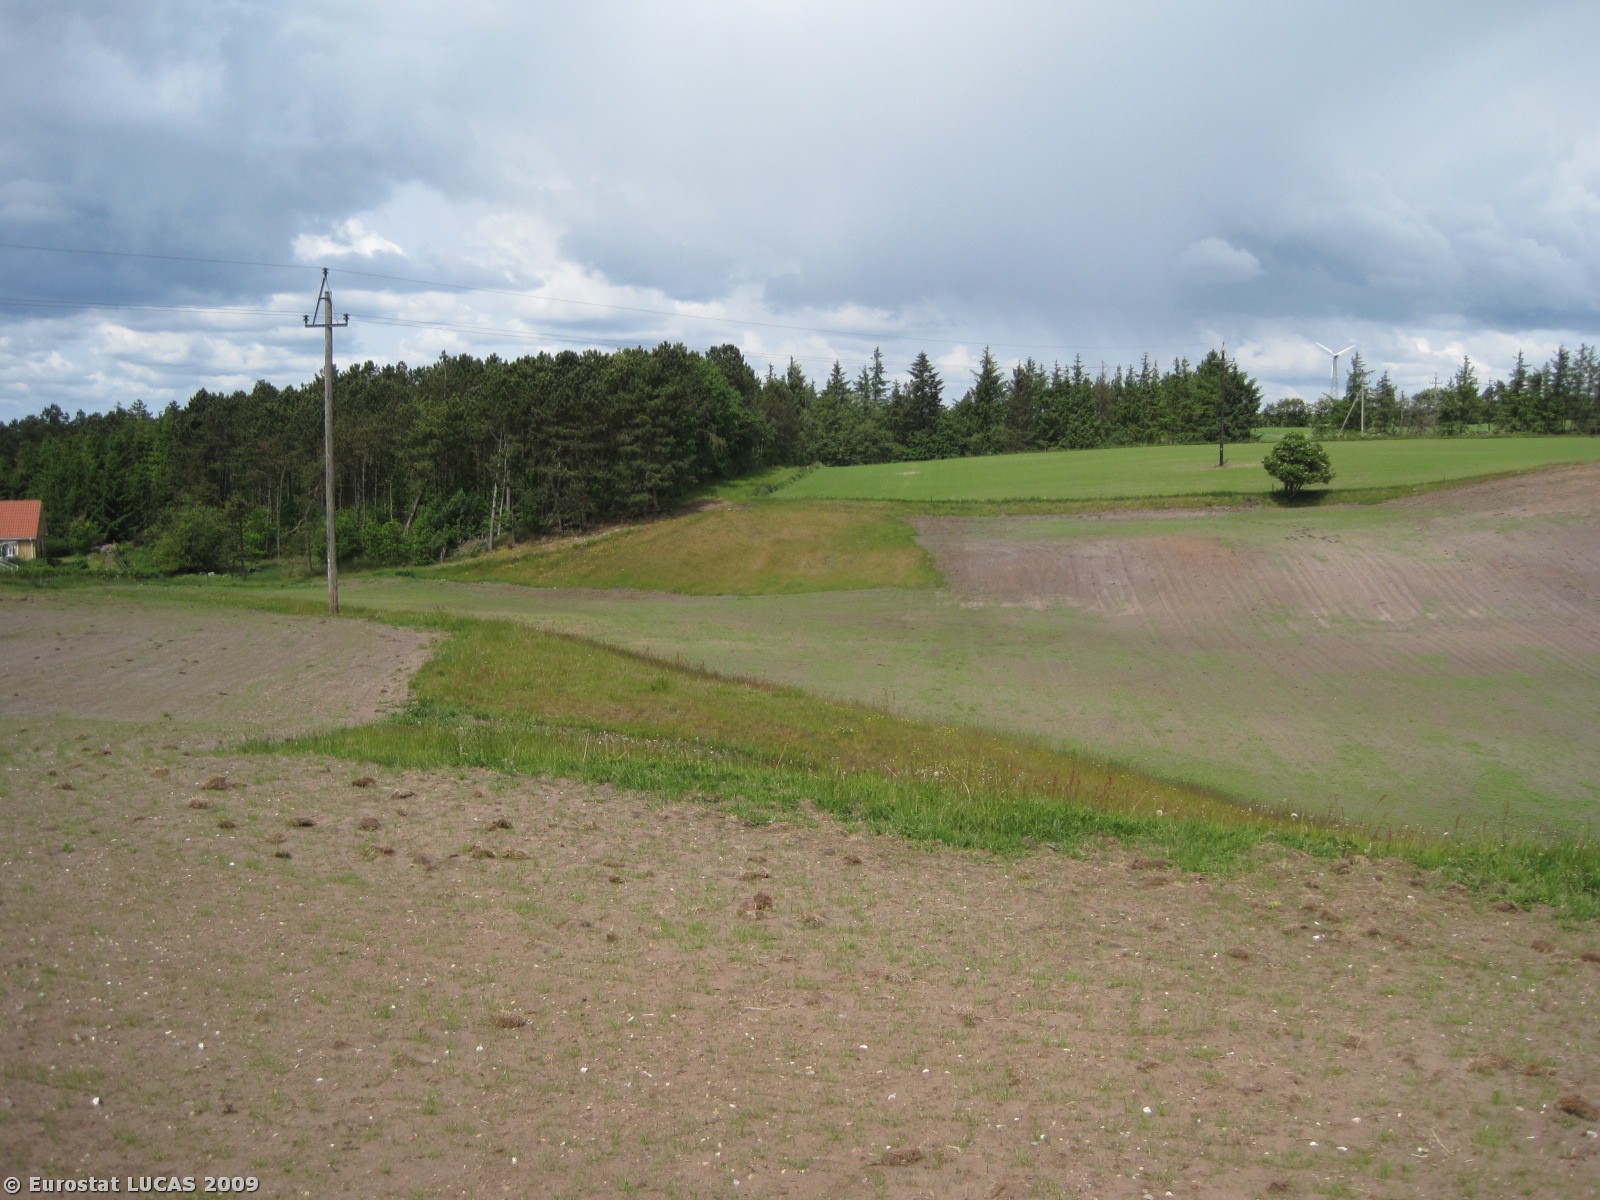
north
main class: Cropland
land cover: Common wheat
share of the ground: < 10 %
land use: Agriculture (excluding fallow land and kitchen gardens)
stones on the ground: 10 - 25 %
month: June
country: DK
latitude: 56.8885
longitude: 9.6886
